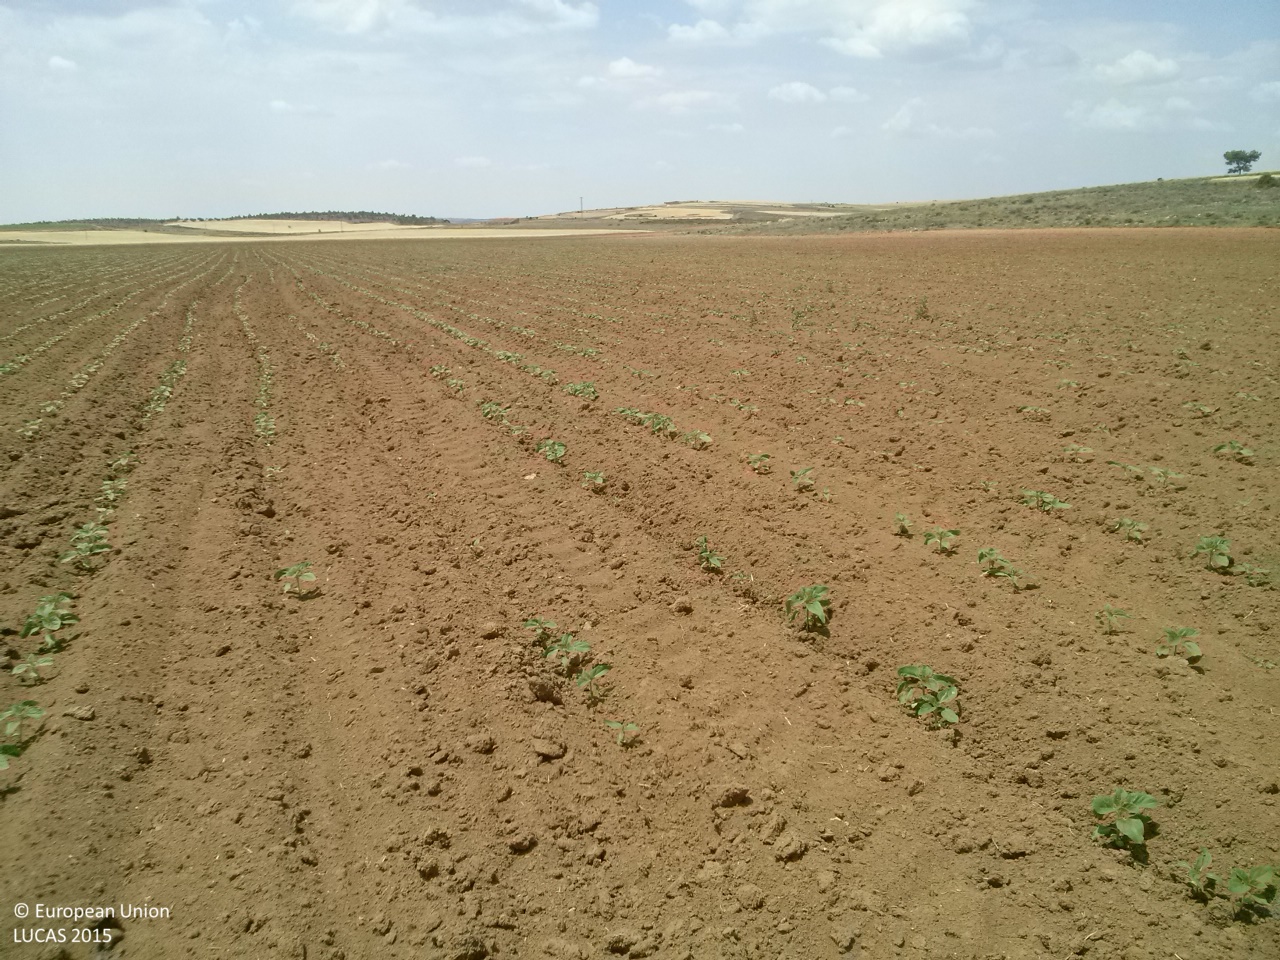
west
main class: Cropland
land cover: Sunflower
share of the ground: < 10 %
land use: Agriculture (excluding fallow land and kitchen gardens)
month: June
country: ES
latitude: 39.9188
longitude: -1.7924
